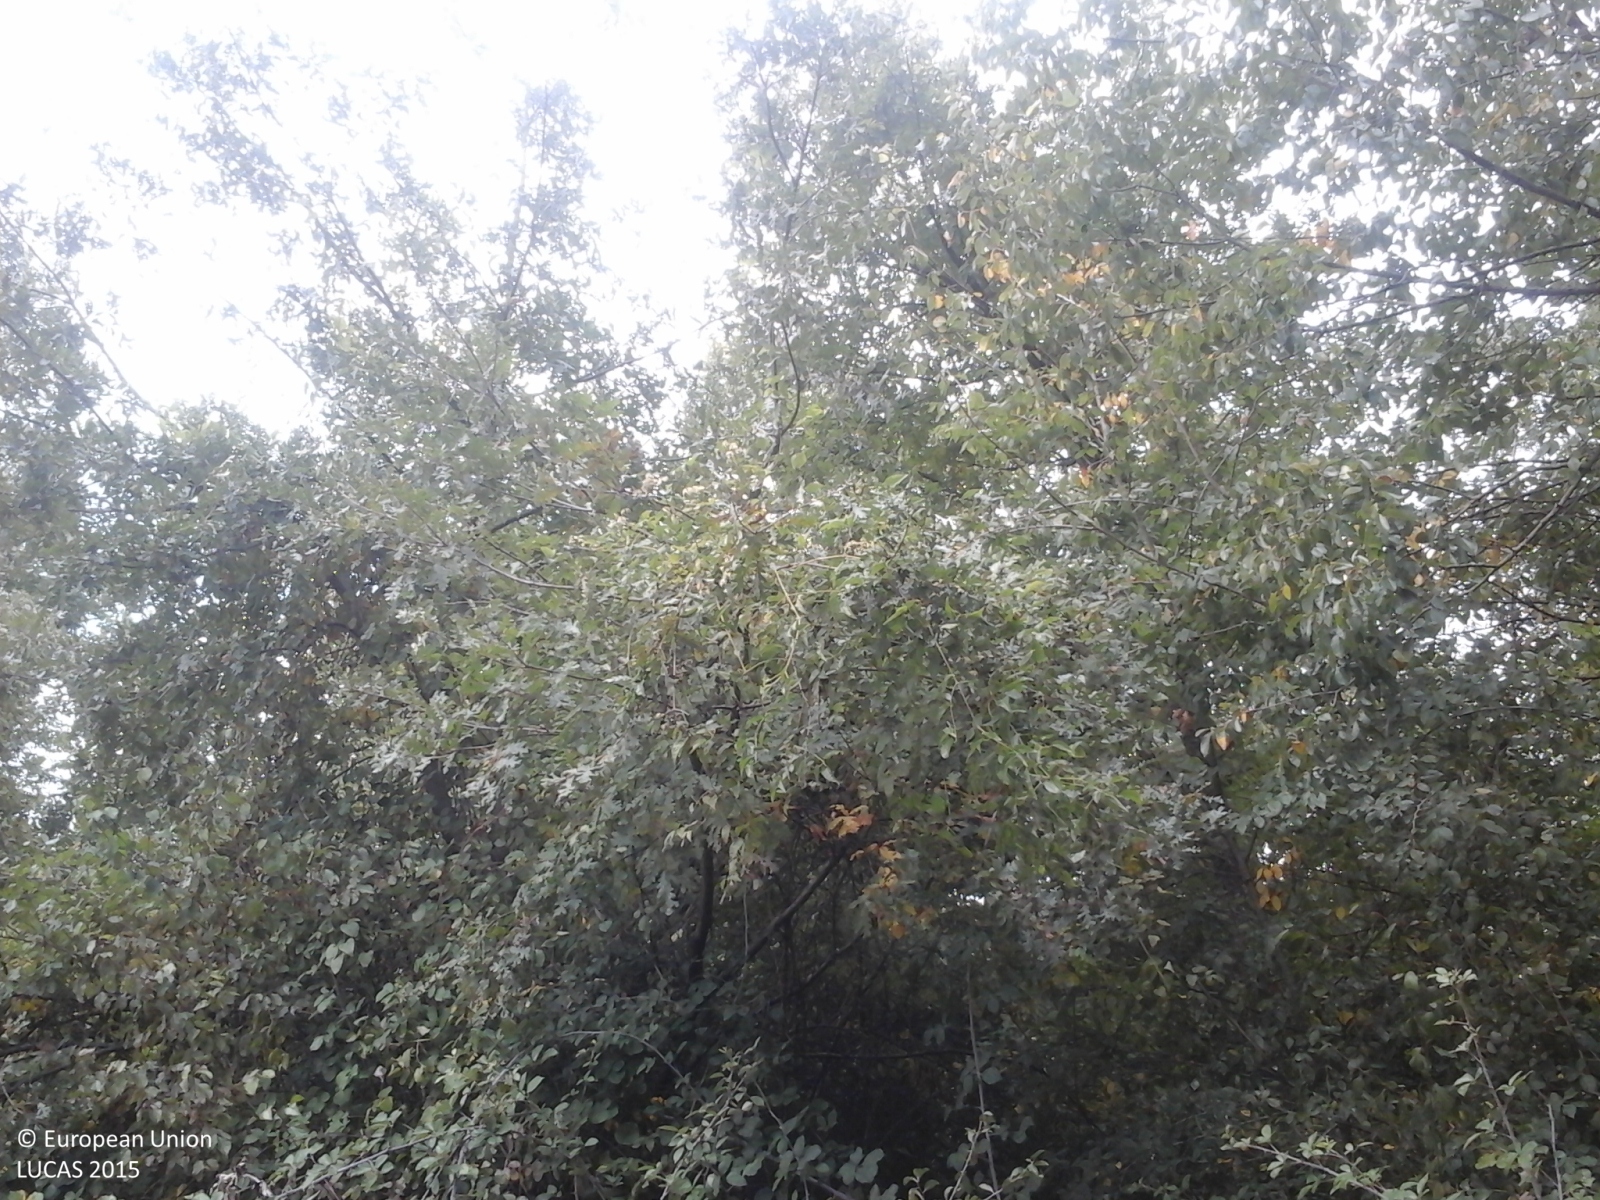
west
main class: Woodland
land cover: Broadleaved woodland
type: thermophilous deciduous forest
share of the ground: > 75 %
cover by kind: broadleaved forest trees 90 %, shrubs 10 %
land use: Forestry
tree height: > 5 m
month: October
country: IT
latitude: 43.4051
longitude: 12.2782
